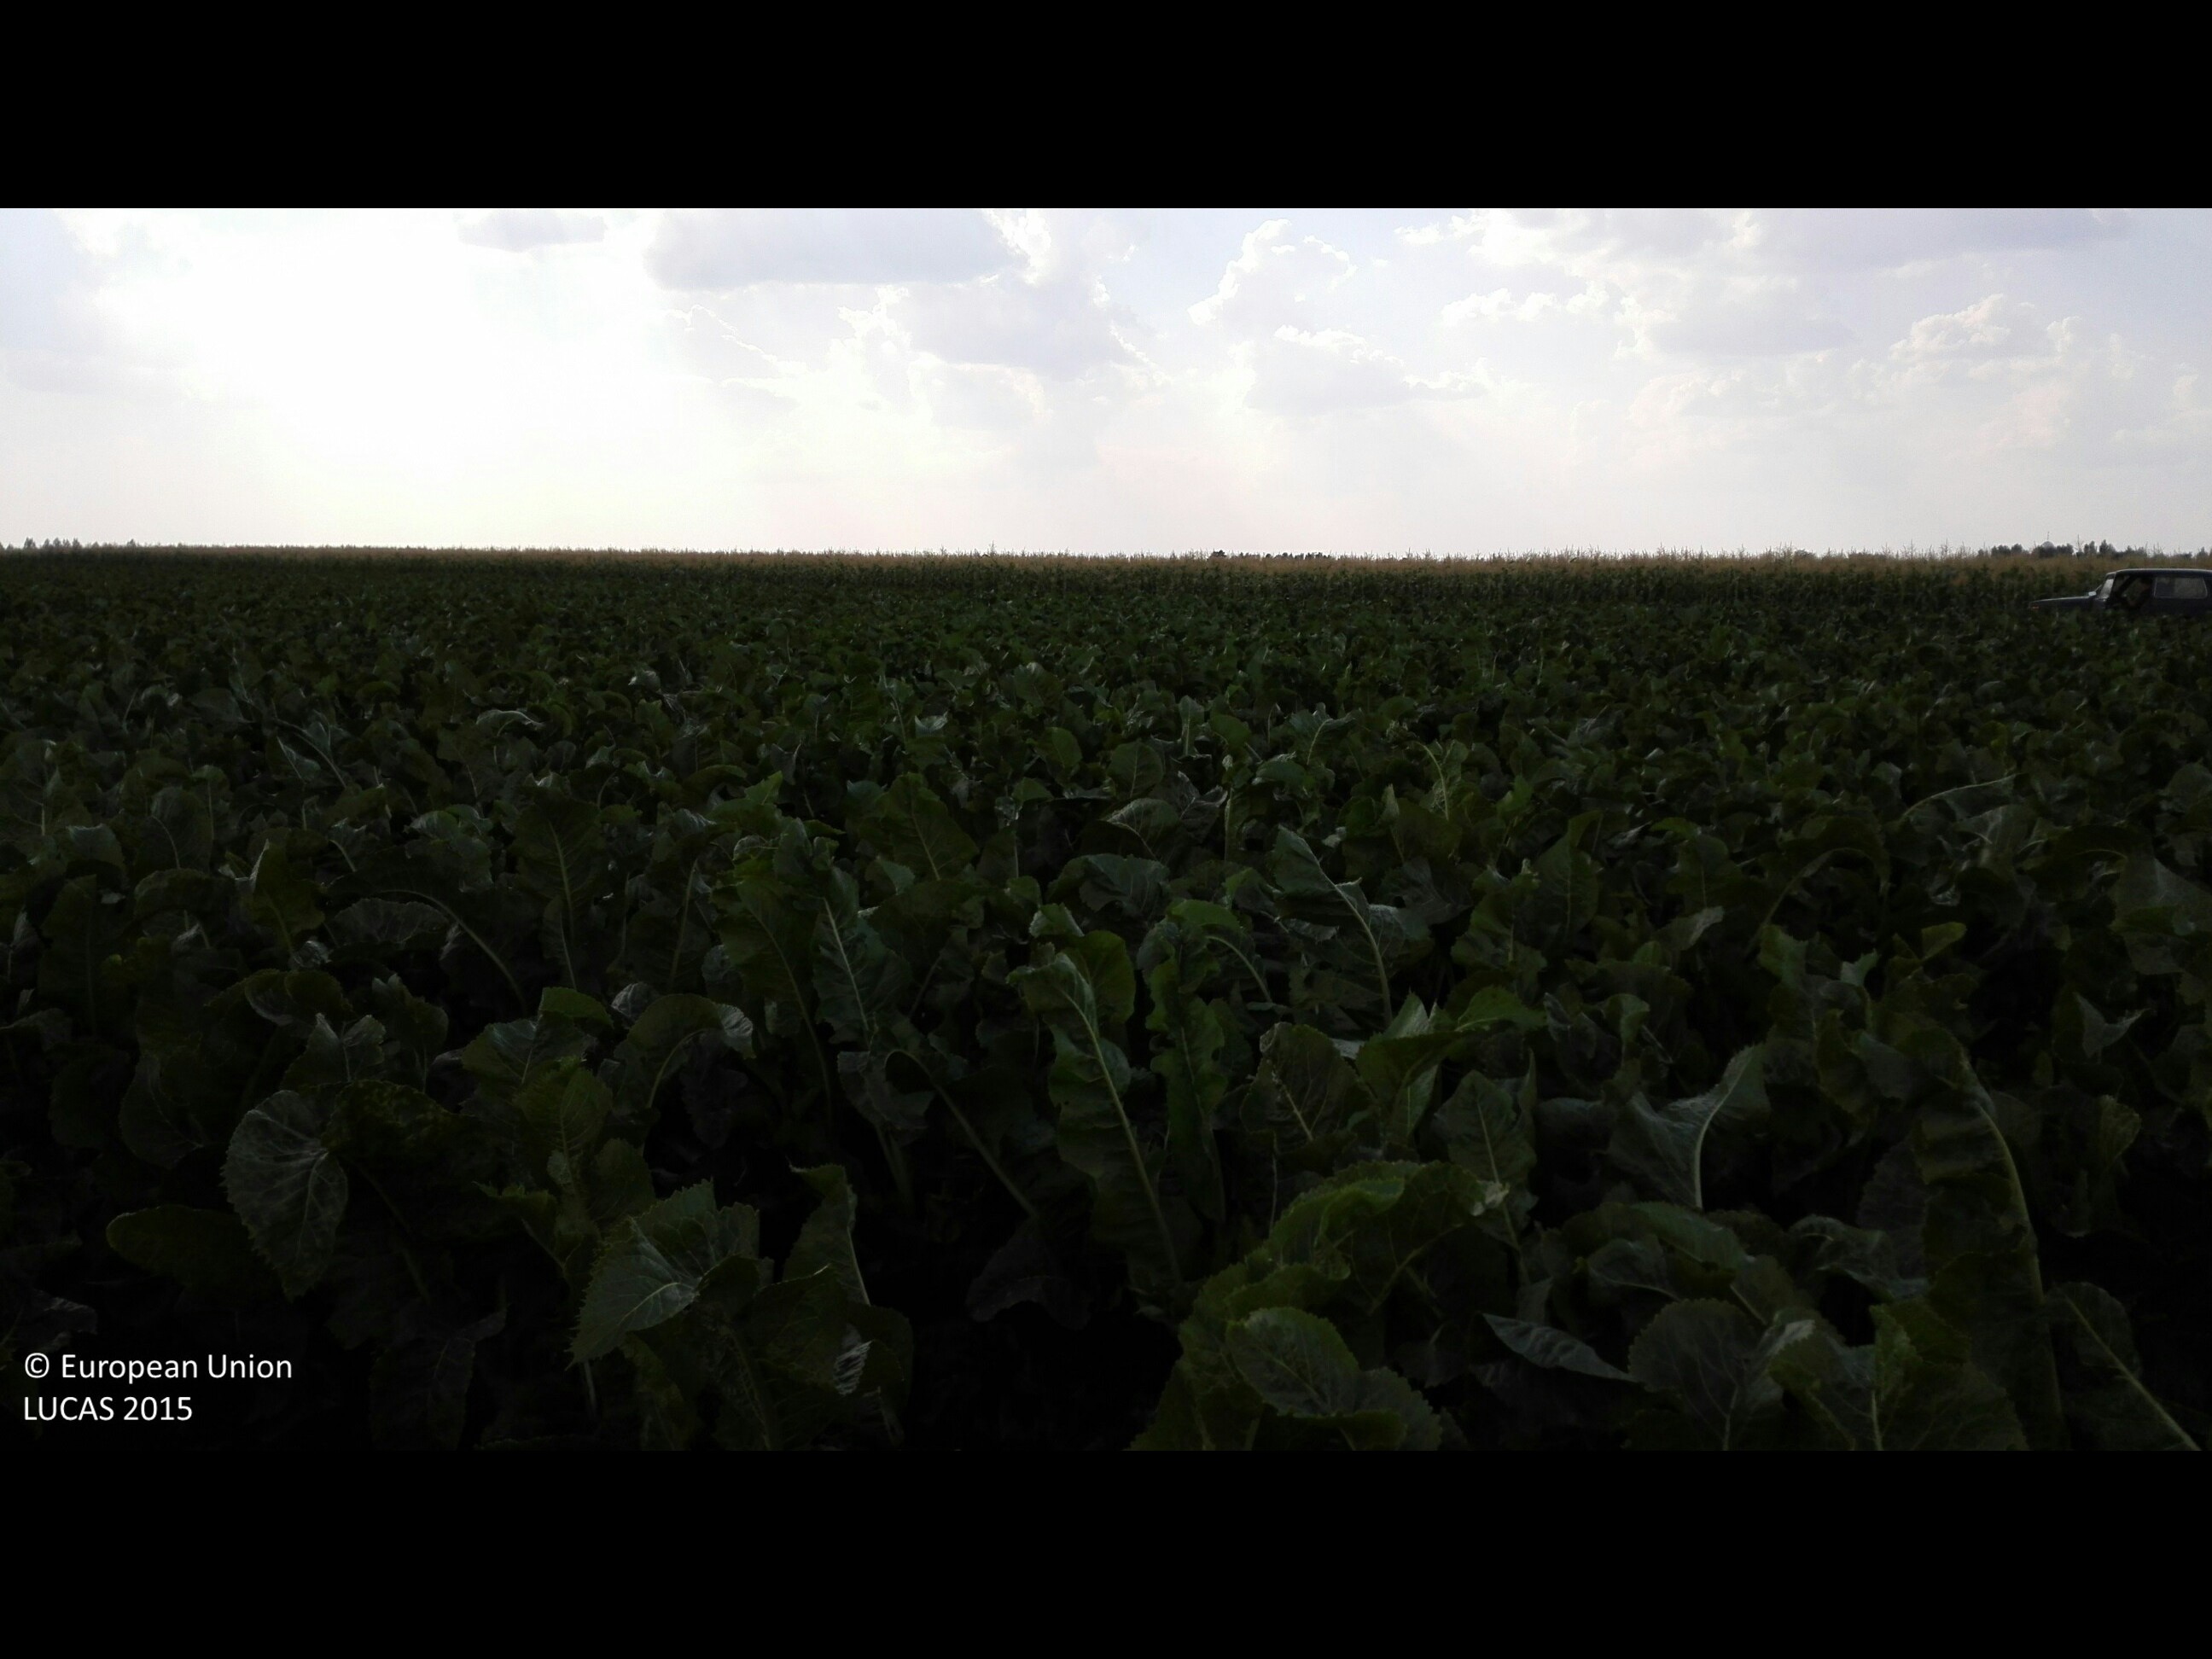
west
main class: Cropland
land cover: Other root crops
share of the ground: > 75 %
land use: Agriculture (excluding fallow land and kitchen gardens)
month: August
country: HU
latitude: 47.4029
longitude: 21.9880
